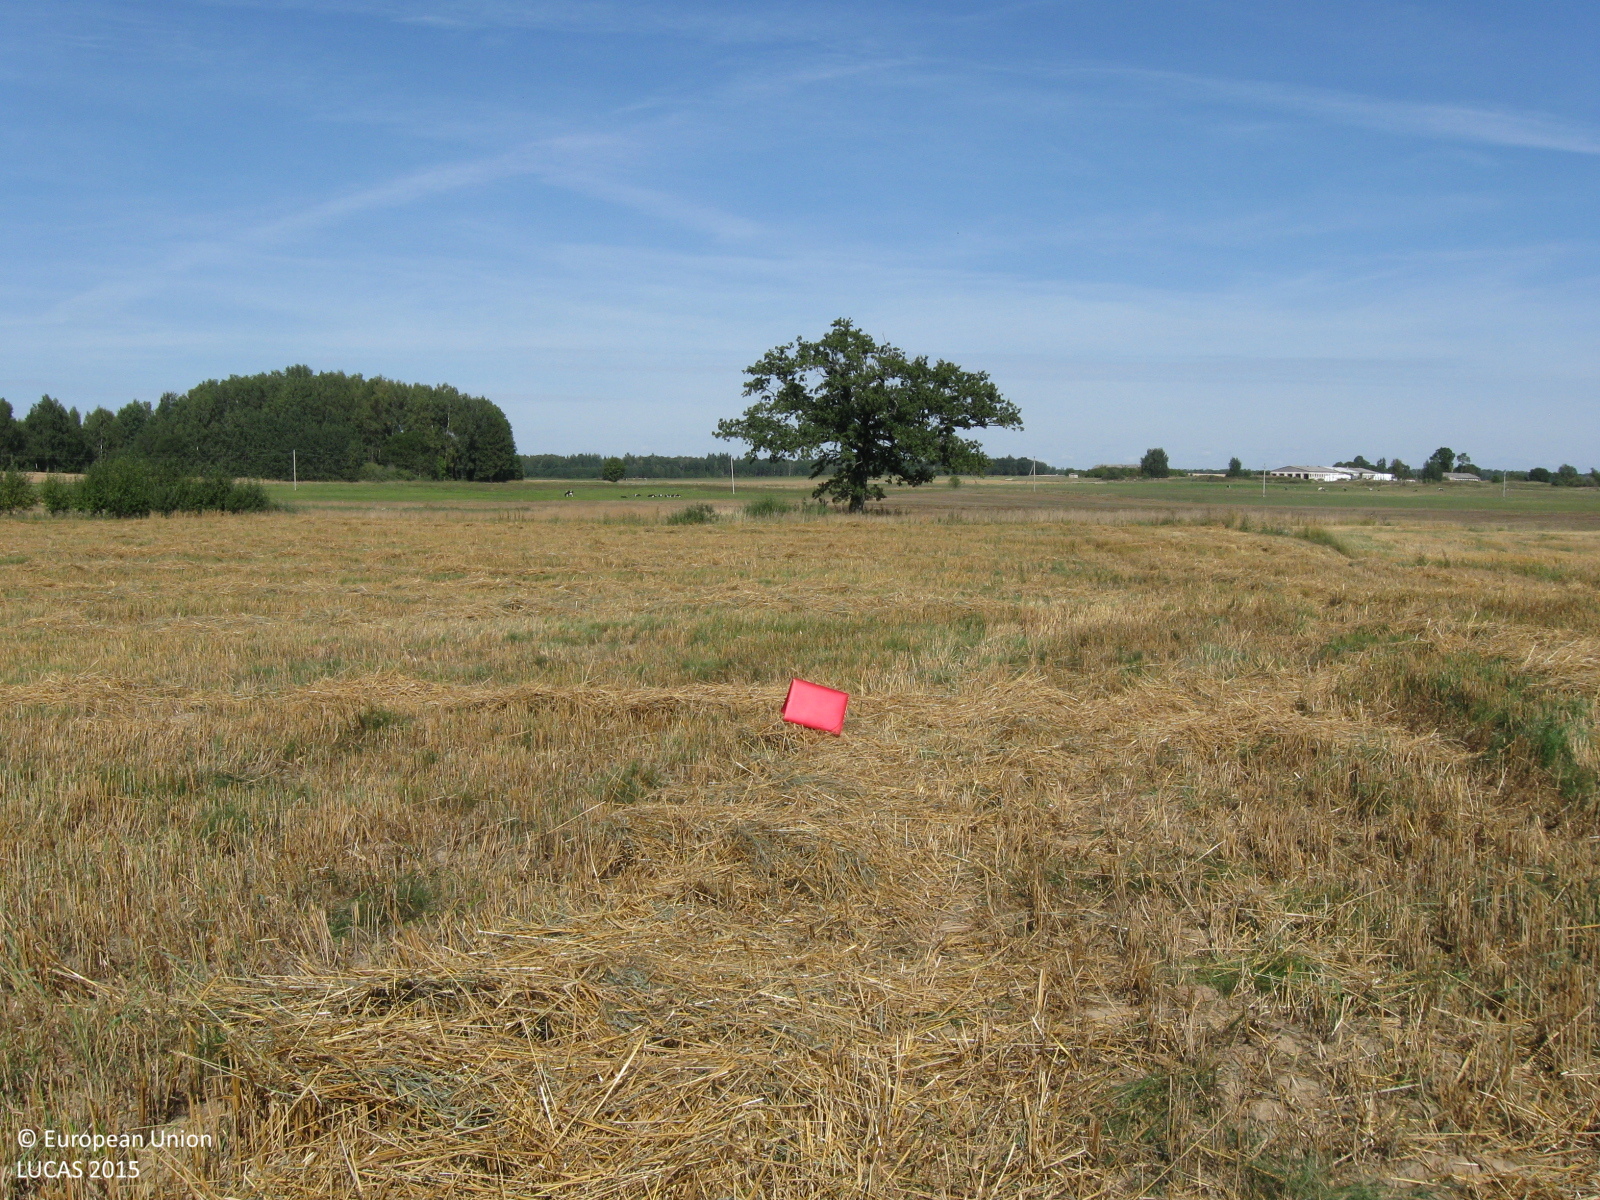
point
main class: Cropland
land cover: Common wheat
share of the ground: > 75 %
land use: Agriculture (excluding fallow land and kitchen gardens)
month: August
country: LT
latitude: 55.4537
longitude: 23.3103
